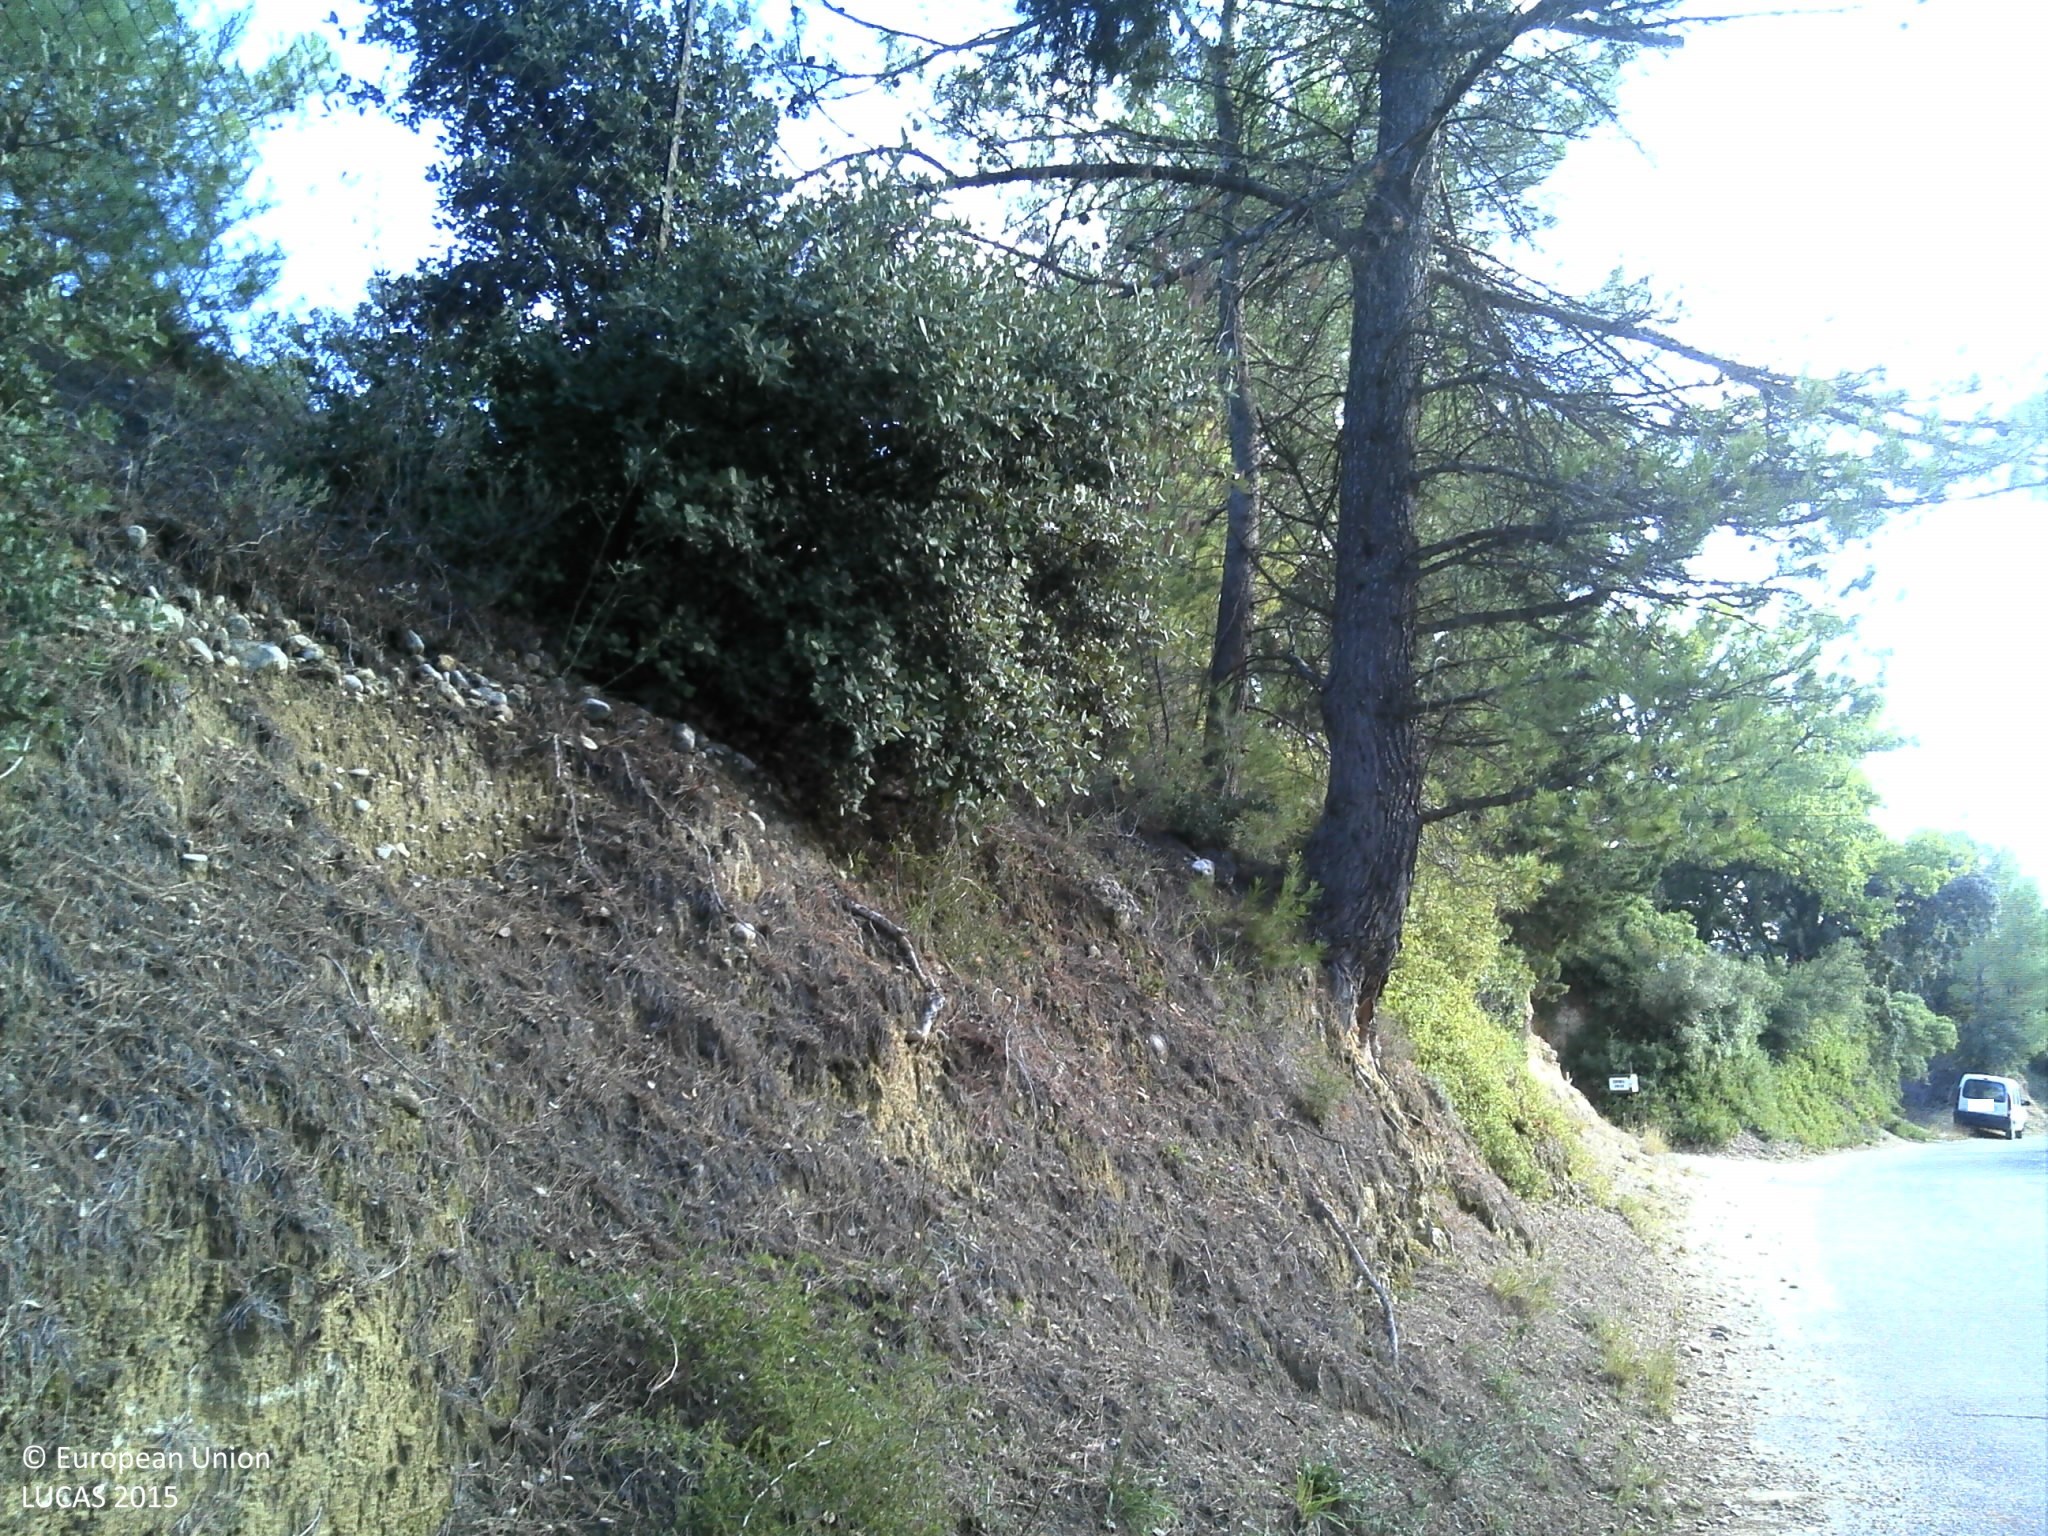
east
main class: Woodland
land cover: Pine dominated mixed woodland
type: coniferous forest of the mediterranean region
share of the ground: 50 - 75 %
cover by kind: coniferous forest trees 40 %, broadleaved forest trees 25 %, unconsolidated bare surface 25 %, herbaceous plants 10 %
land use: Residential
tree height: > 5 m
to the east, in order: Pine dominated mixed woodland; Fences; Tracks; Electric lines; Pine dominated mixed woodland; Electric lines; Pine dominated mixed woodland; Tracks; Pine dominated mixed woodland
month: October
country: FR
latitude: 44.0531
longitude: 5.0779
